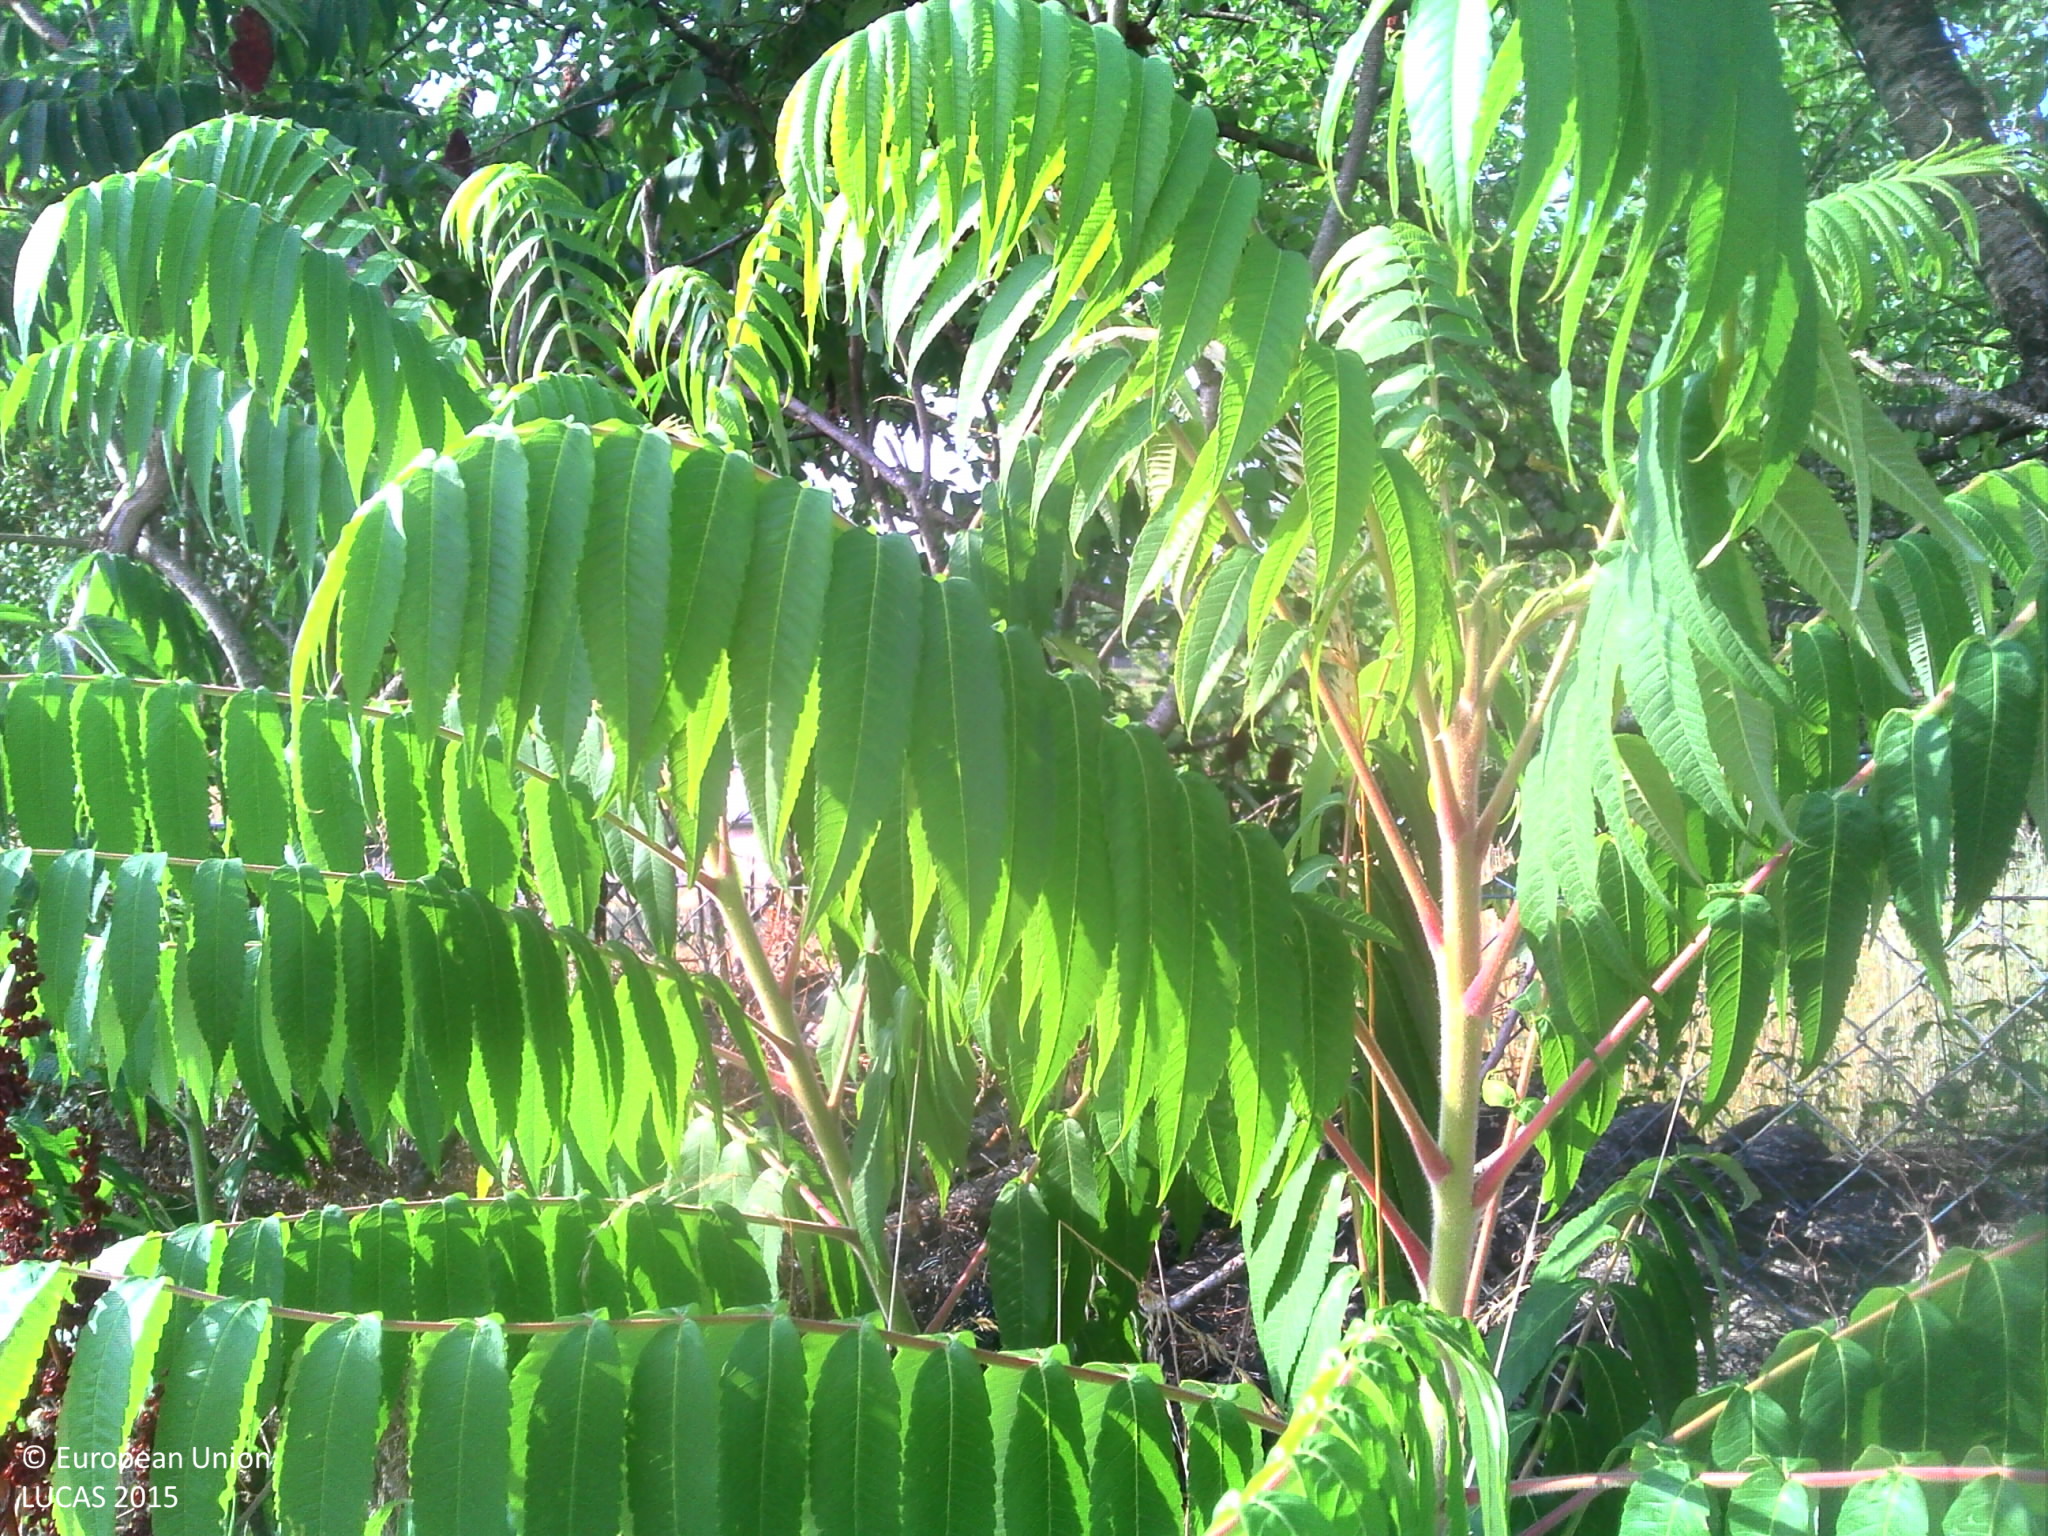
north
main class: Grassland
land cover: Grassland with sparse tree/shrub cover
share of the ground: > 75 %
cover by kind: herbaceous plants 95 %, coniferous forest trees 5 %
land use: Residential
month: July
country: FR
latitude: 45.6476
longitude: 5.1924
